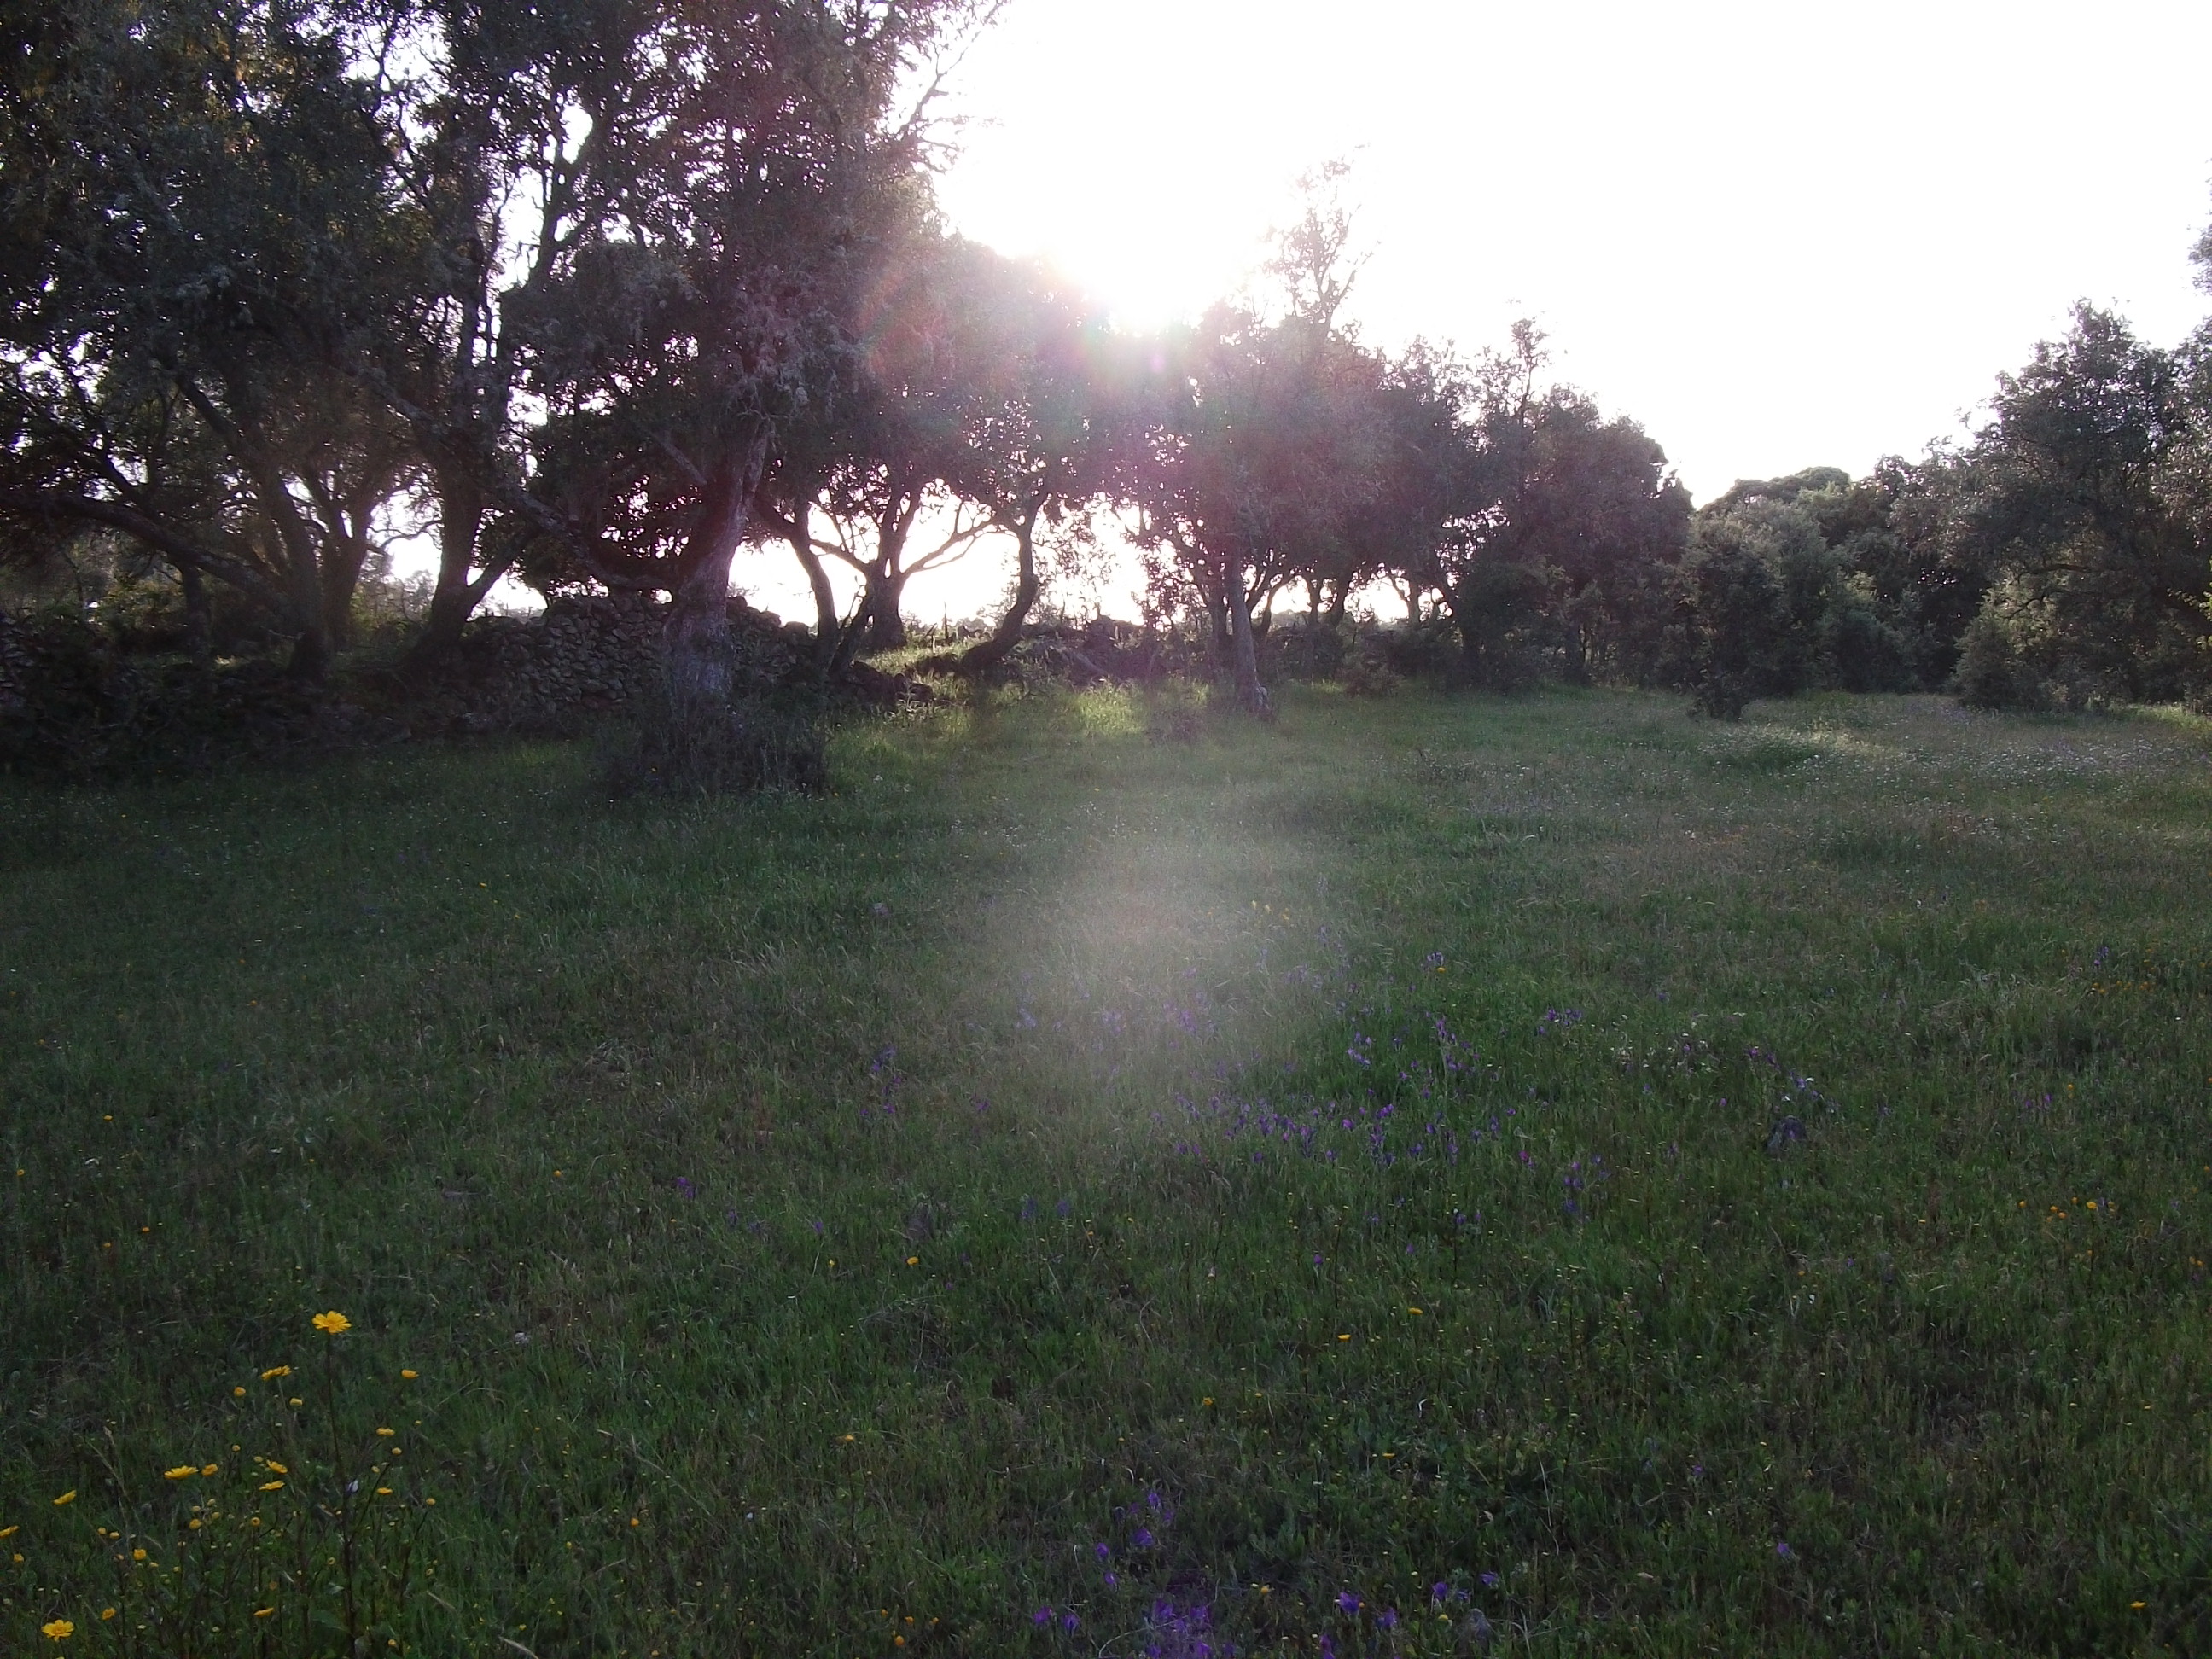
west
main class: Cropland
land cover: Olive groves
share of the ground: 25 - 50 %
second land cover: Spontaneously vegetated surfaces
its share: > 75 %
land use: Agriculture (excluding fallow land and kitchen gardens)
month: April
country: ES
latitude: 38.0798
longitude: -6.6358
